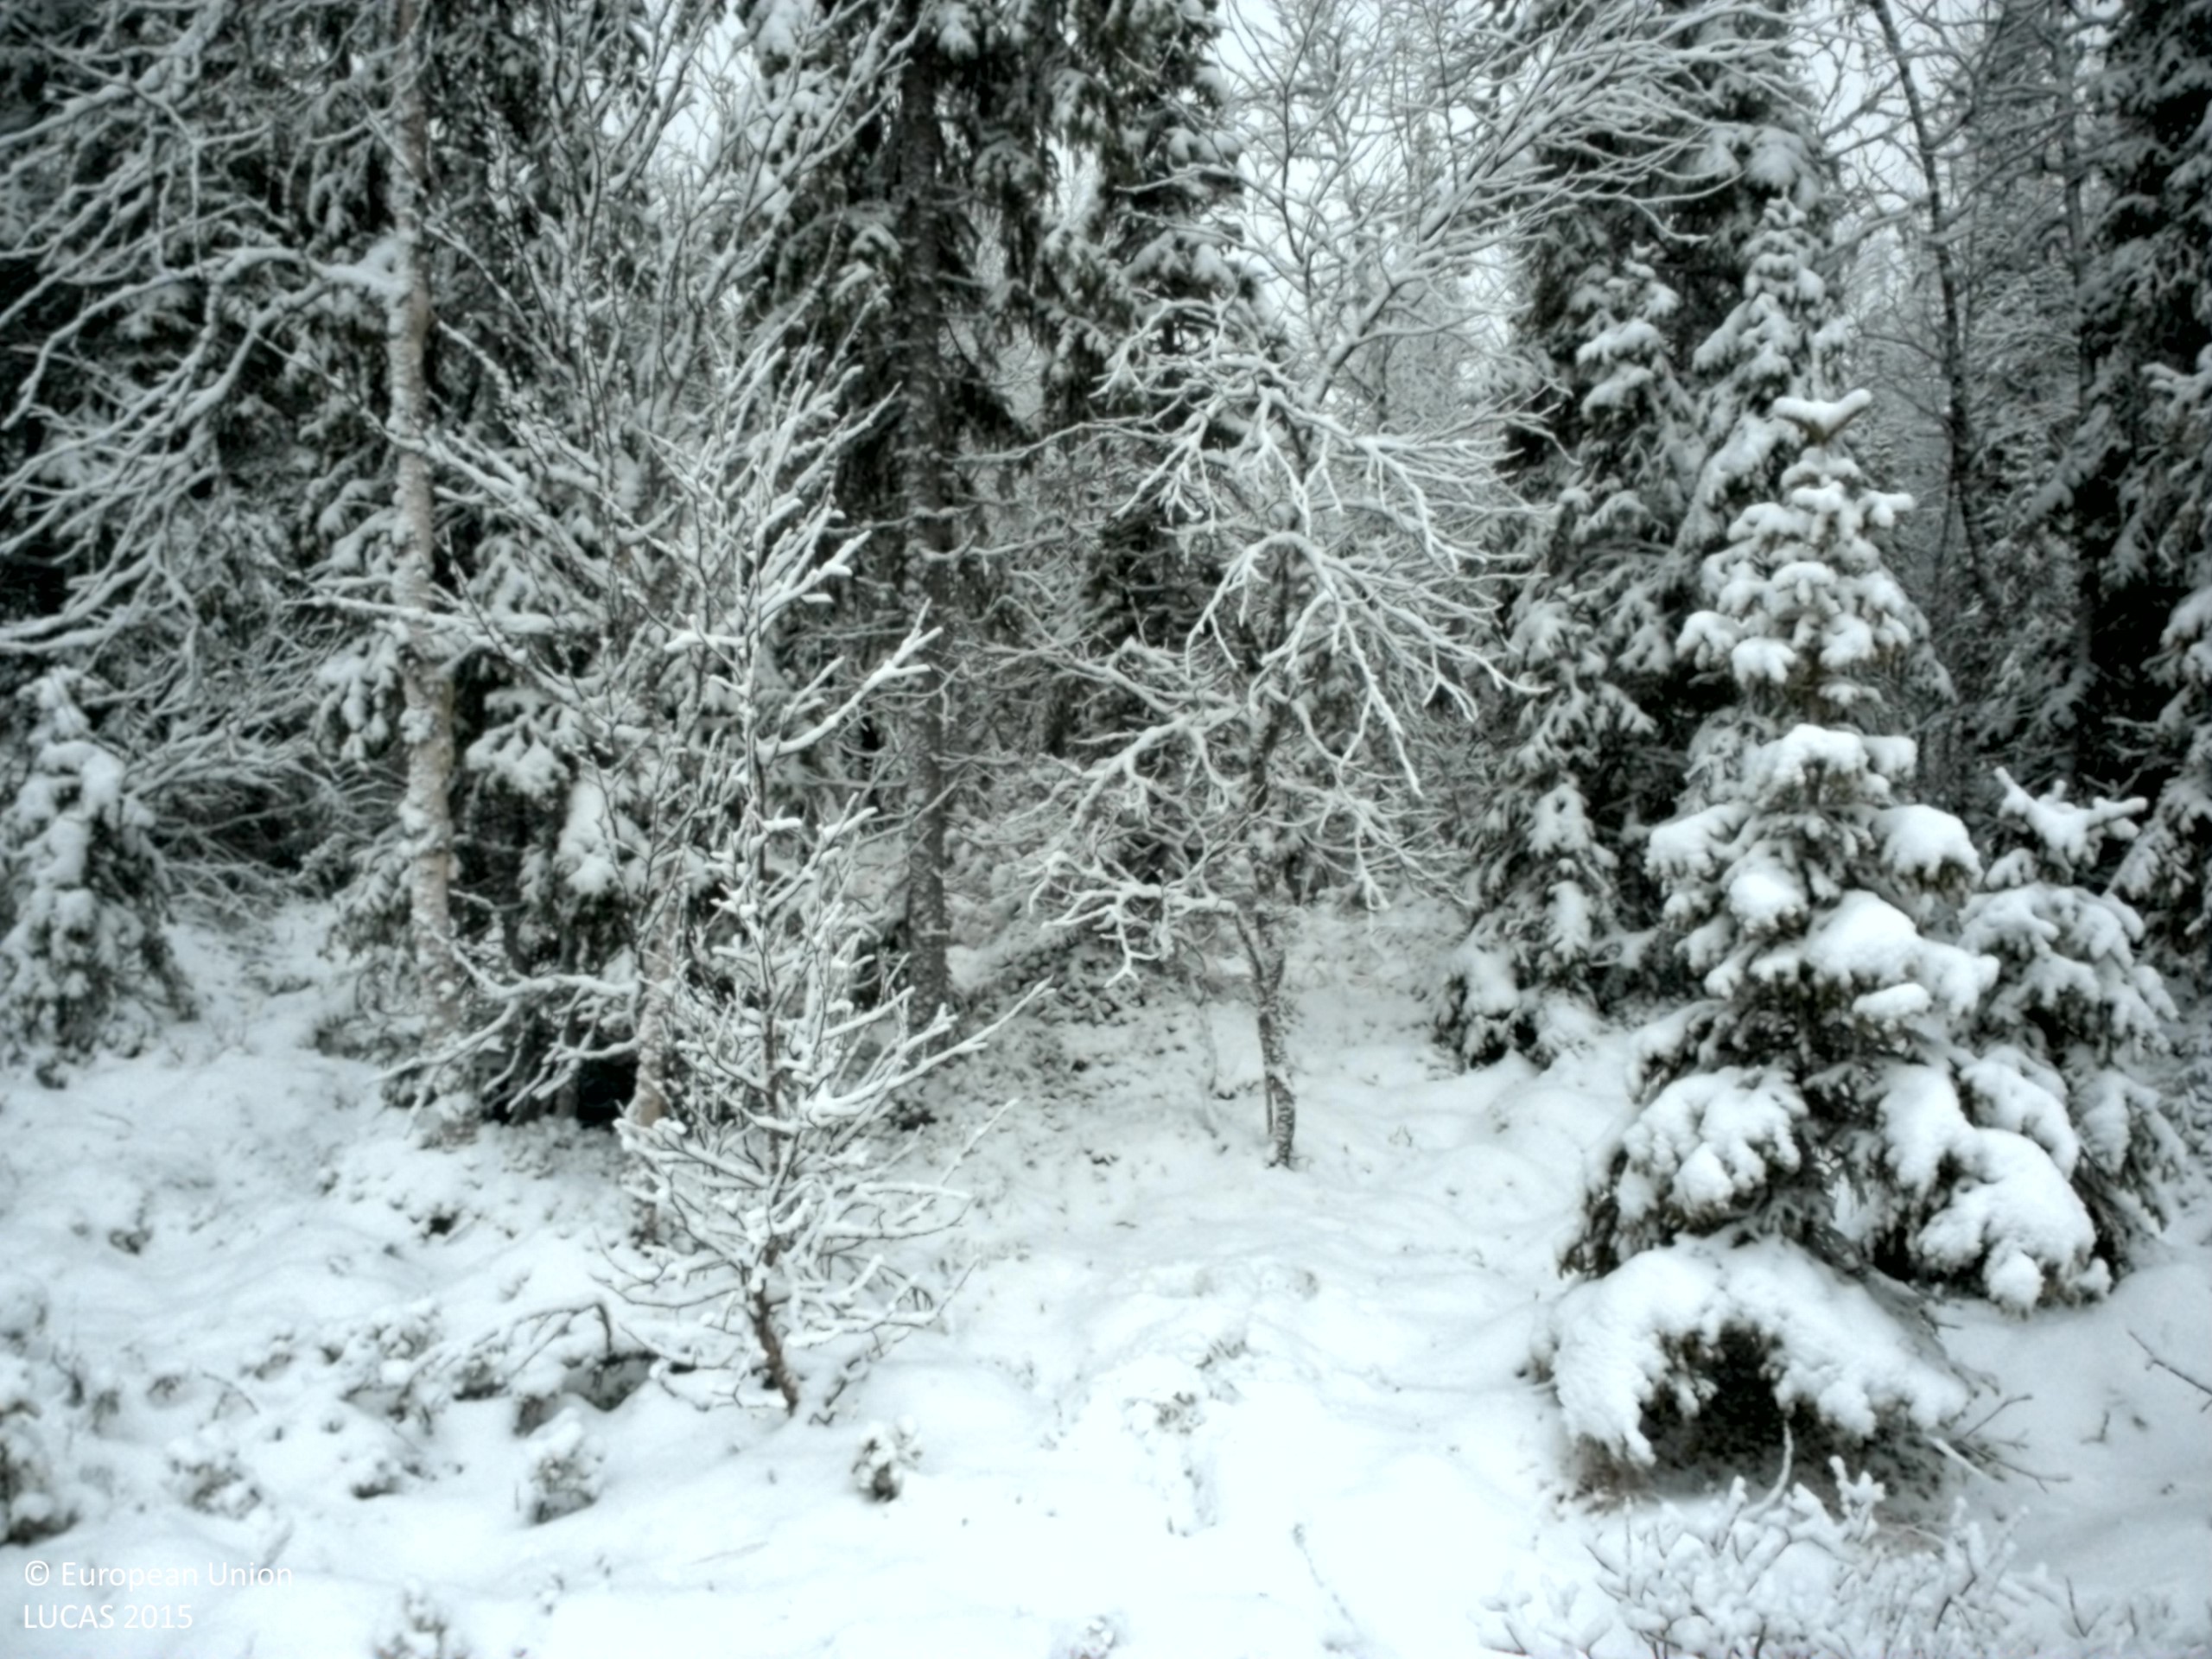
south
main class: Woodland
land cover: Pine dominated mixed woodland
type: boreal forest
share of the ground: 25 - 50 %
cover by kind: broadleaved forest trees 30 %, herbaceous plants 30 %, coniferous forest trees 15 %, shrubs 15 %, lichens and mosses 10 %
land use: Forestry
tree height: < 5 m
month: November
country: SE
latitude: 63.7692
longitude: 15.2267
